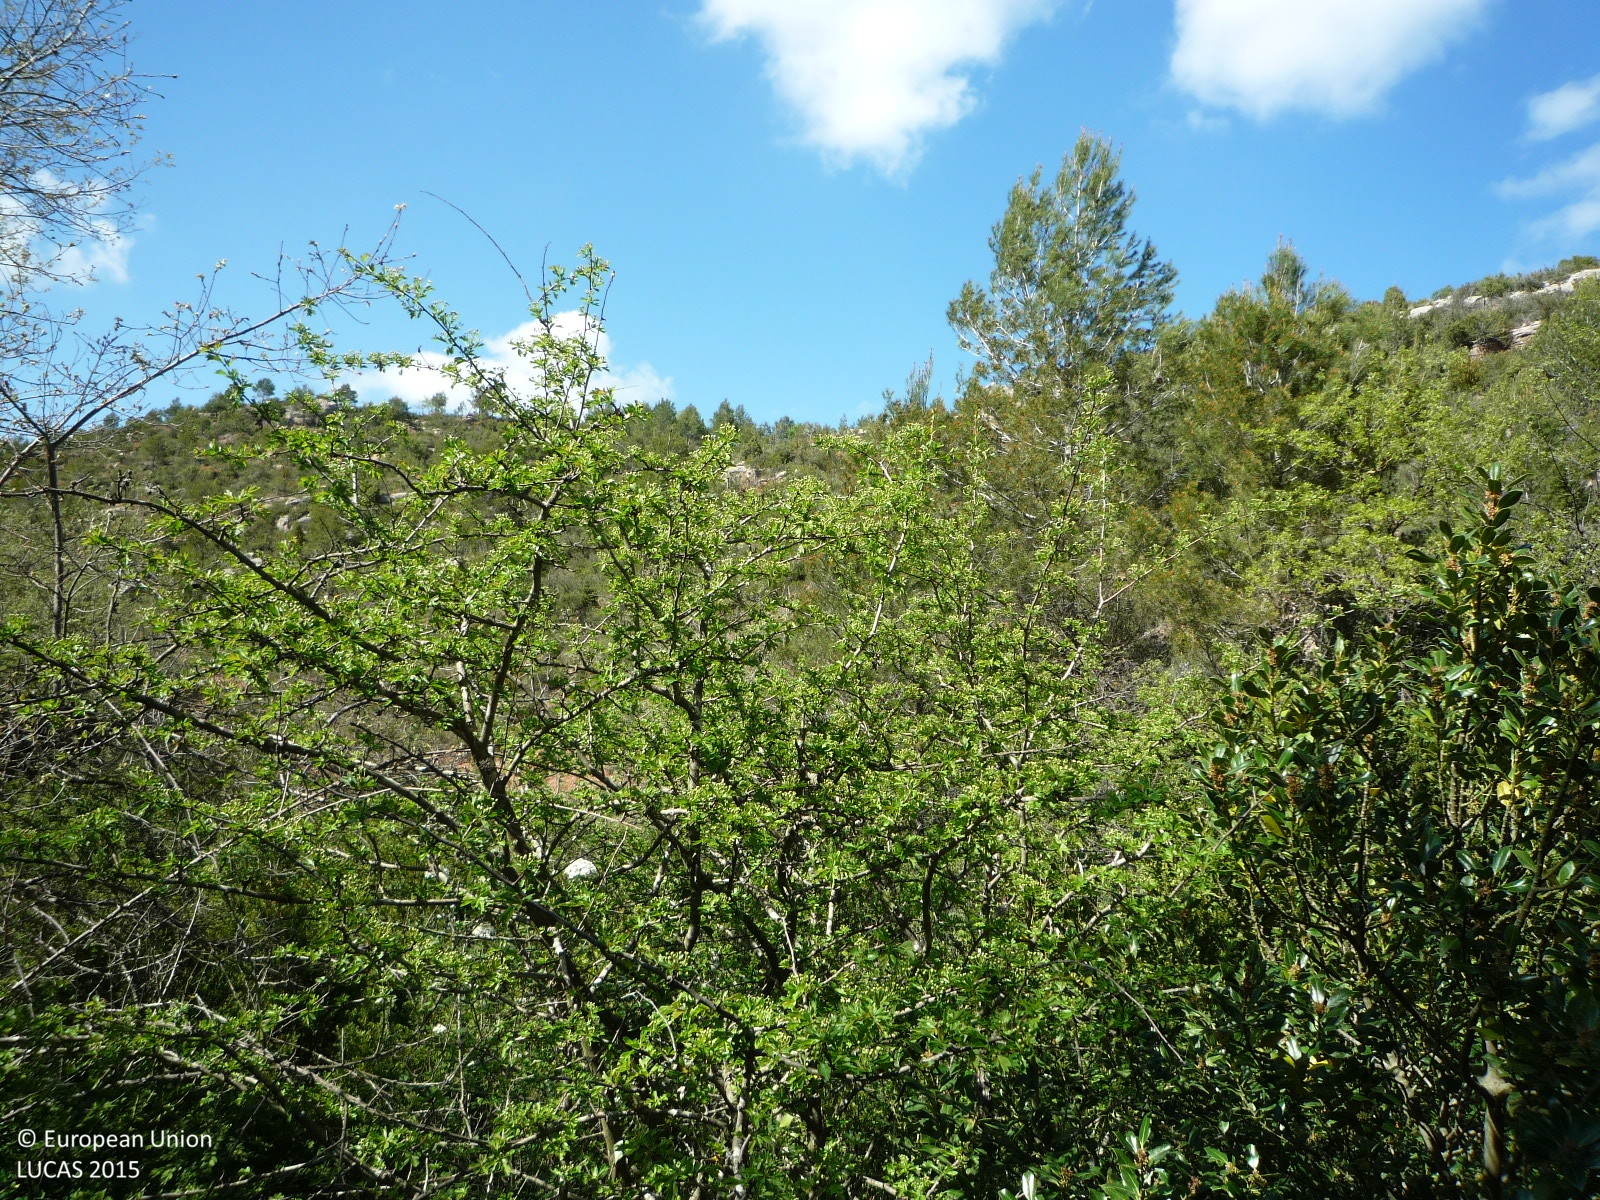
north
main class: Woodland
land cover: Pine dominated mixed woodland
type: coniferous forest of the mediterranean region
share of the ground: > 75 %
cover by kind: coniferous forest trees 75 %, broadleaved forest trees 25 %
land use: Forestry
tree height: < 5 m
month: April
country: ES
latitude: 41.6709
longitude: 1.6192
